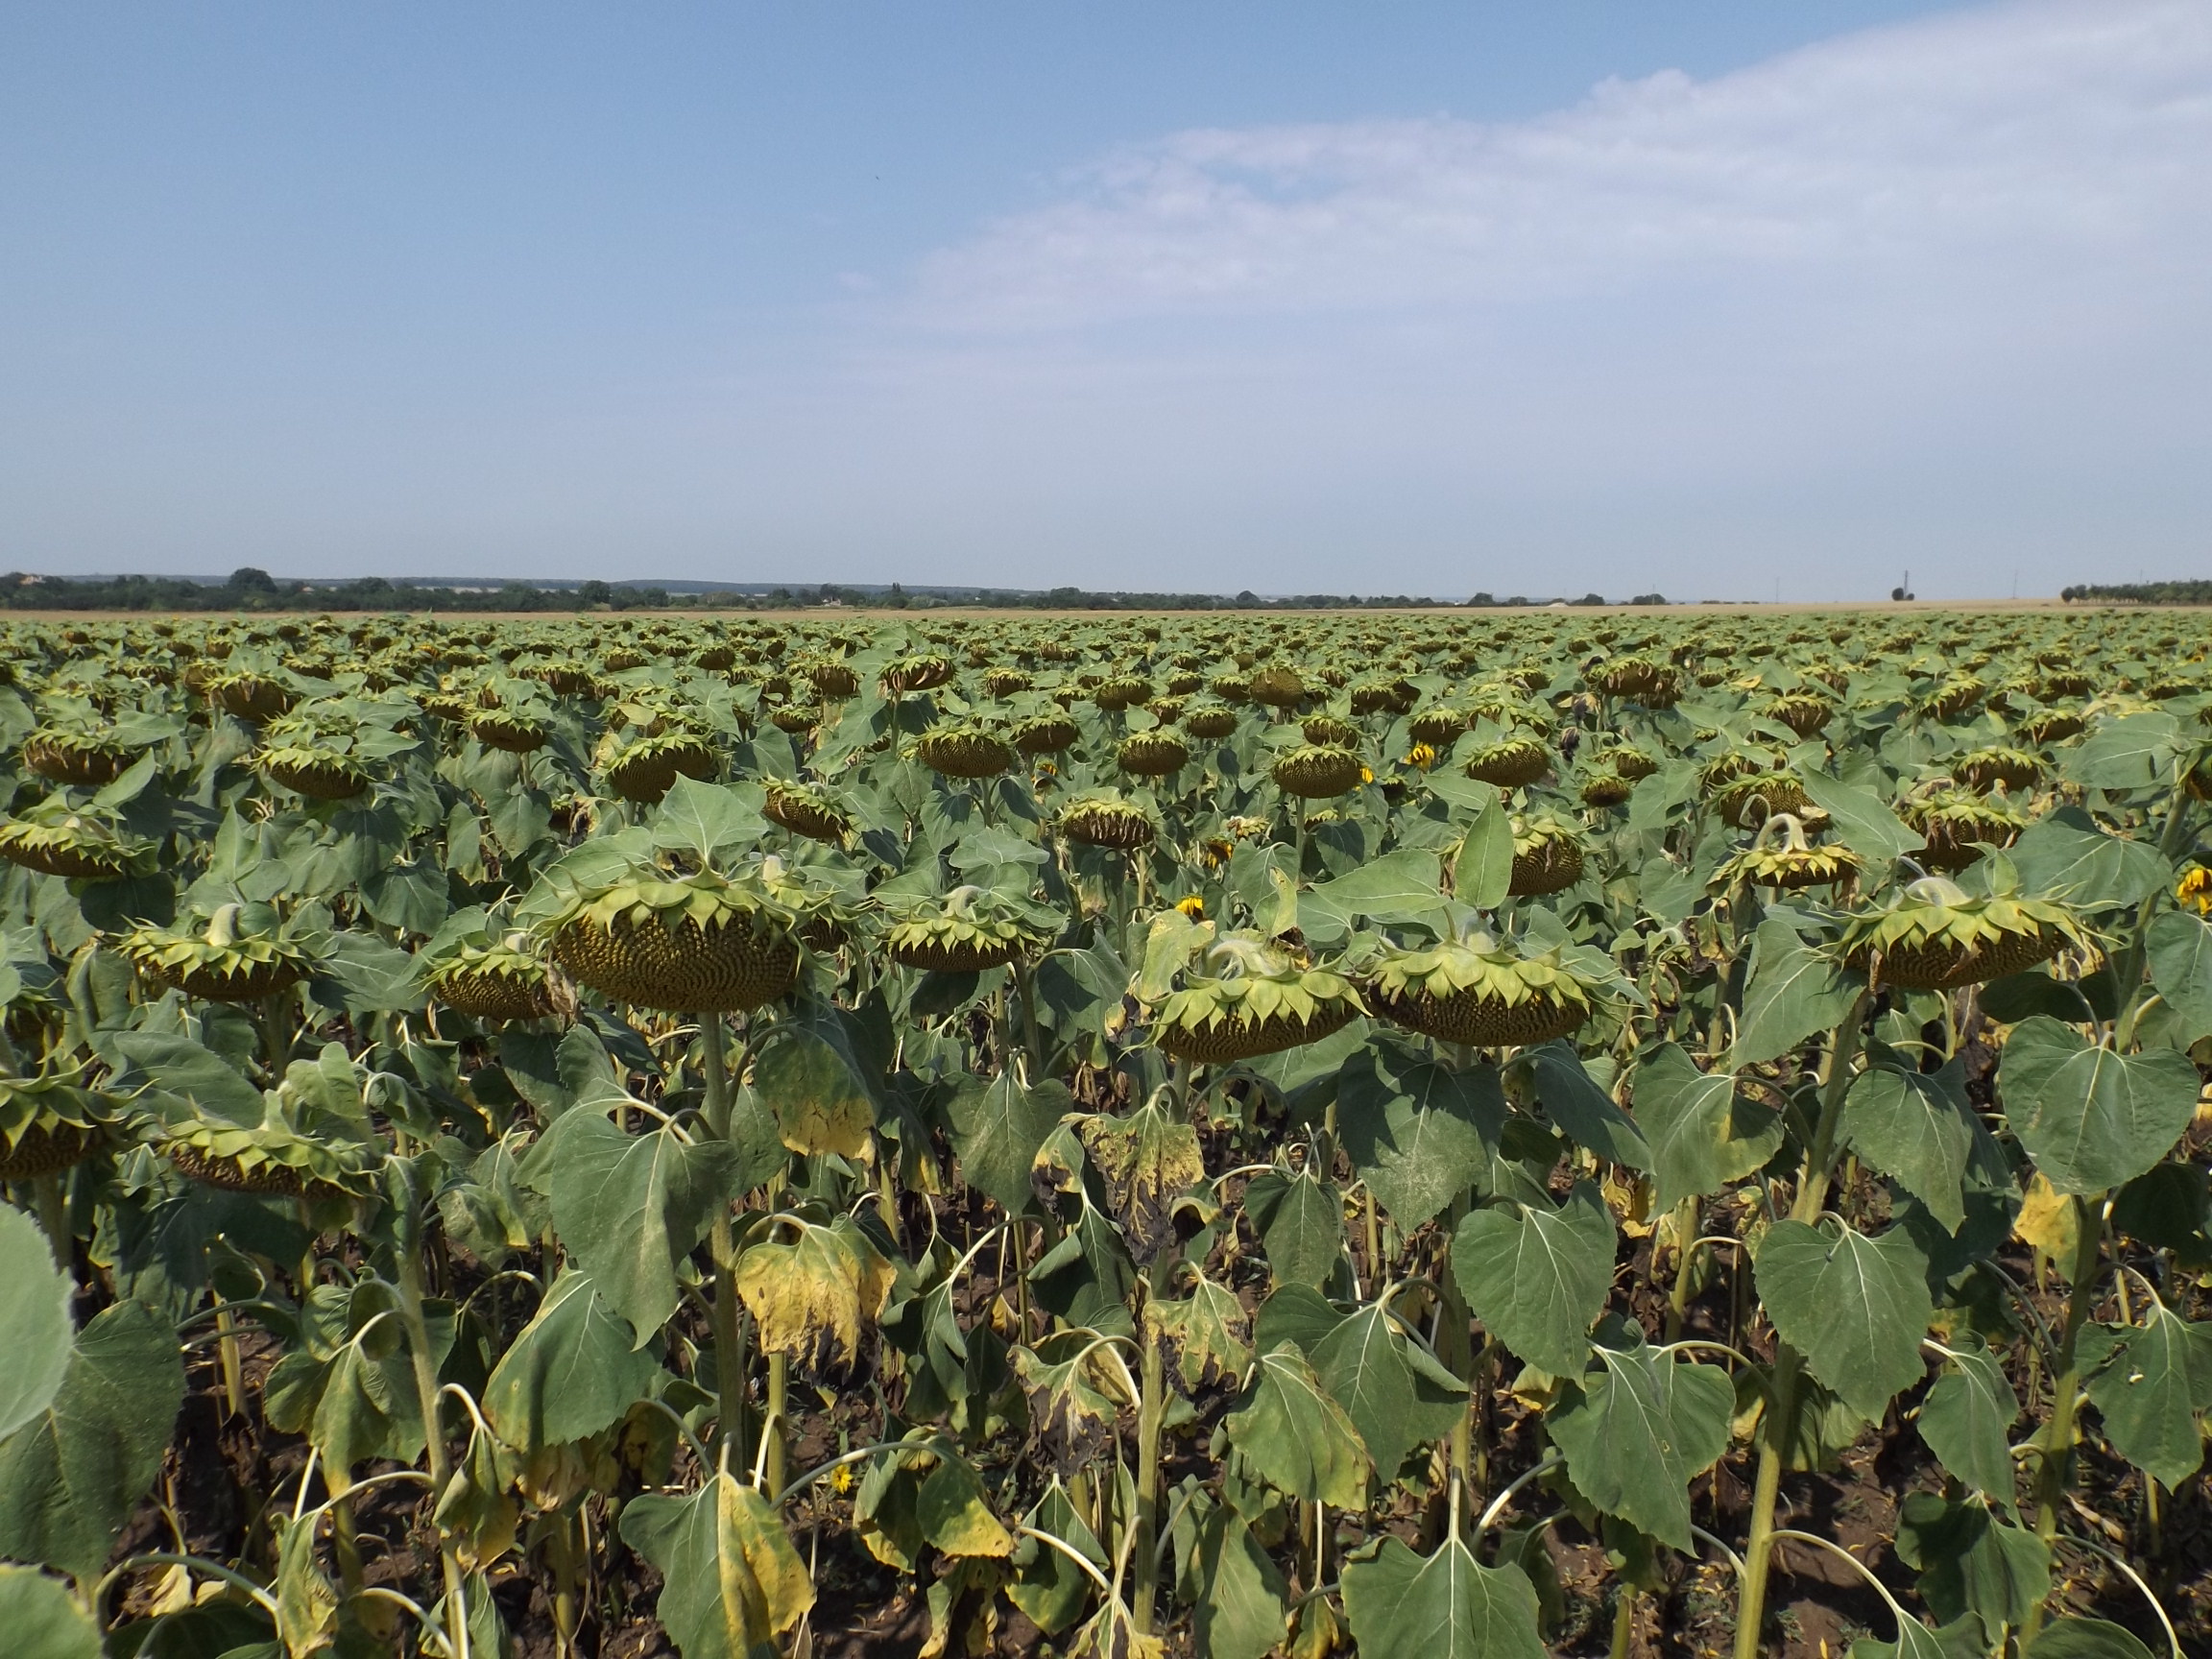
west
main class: Cropland
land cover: Sunflower
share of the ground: > 75 %
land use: Agriculture (excluding fallow land and kitchen gardens)
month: July
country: BG
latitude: 43.4881
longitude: 27.4276
